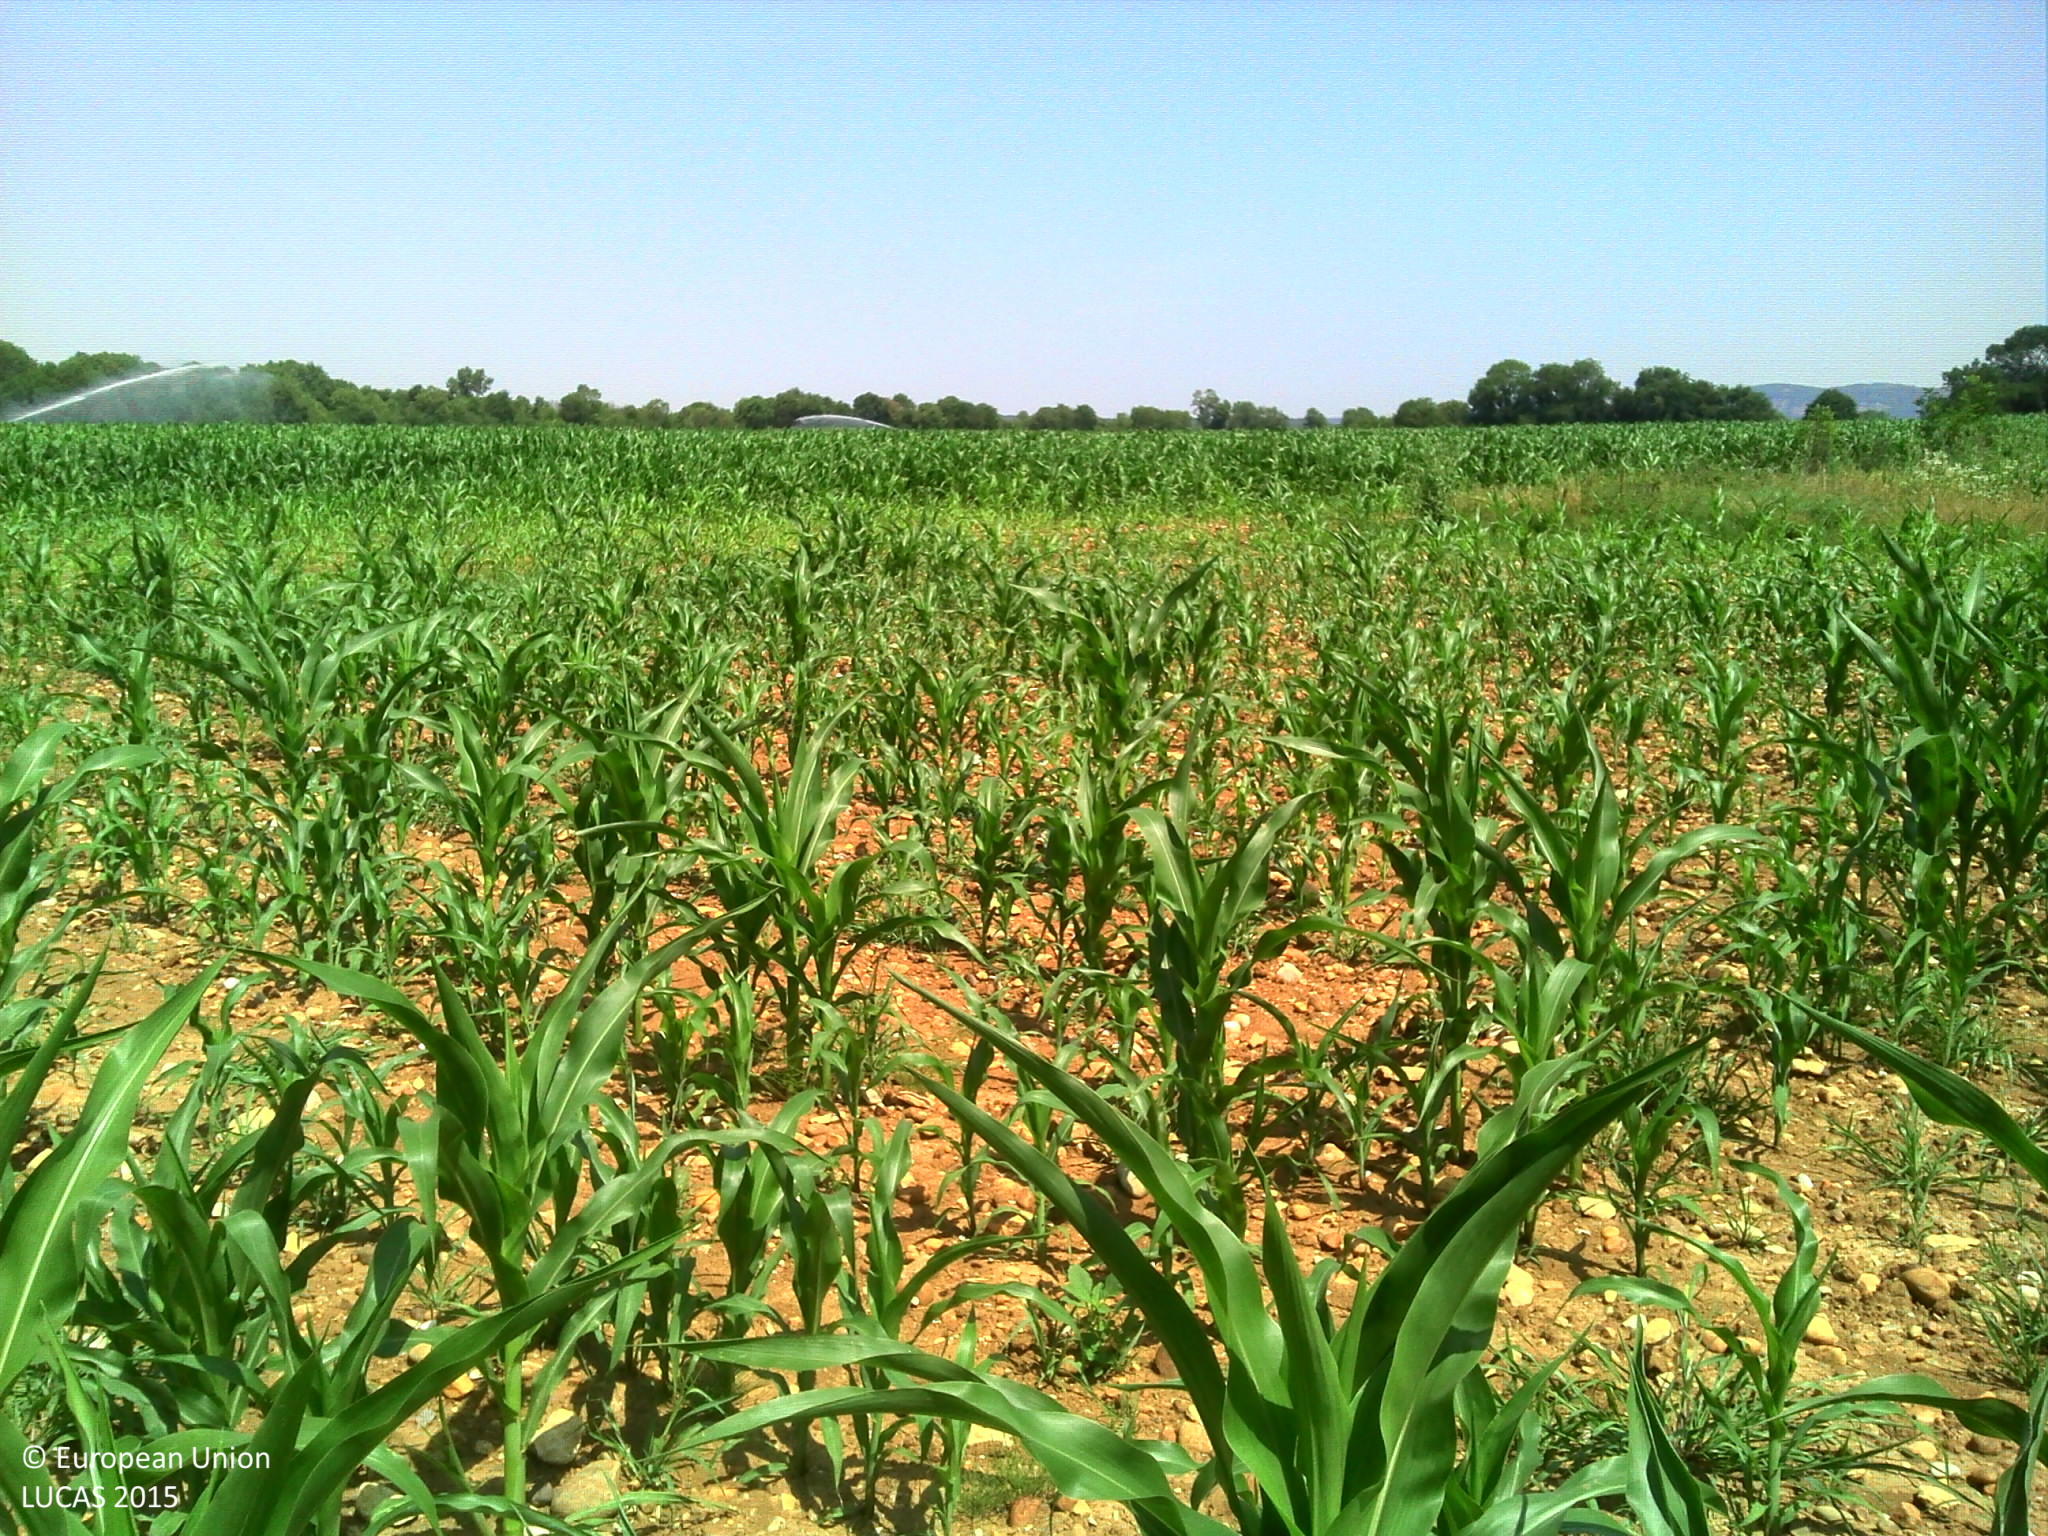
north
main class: Cropland
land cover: Maize
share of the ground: 25 - 50 %
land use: Agriculture (excluding fallow land and kitchen gardens)
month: July
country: FR
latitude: 45.8174
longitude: 5.3578
